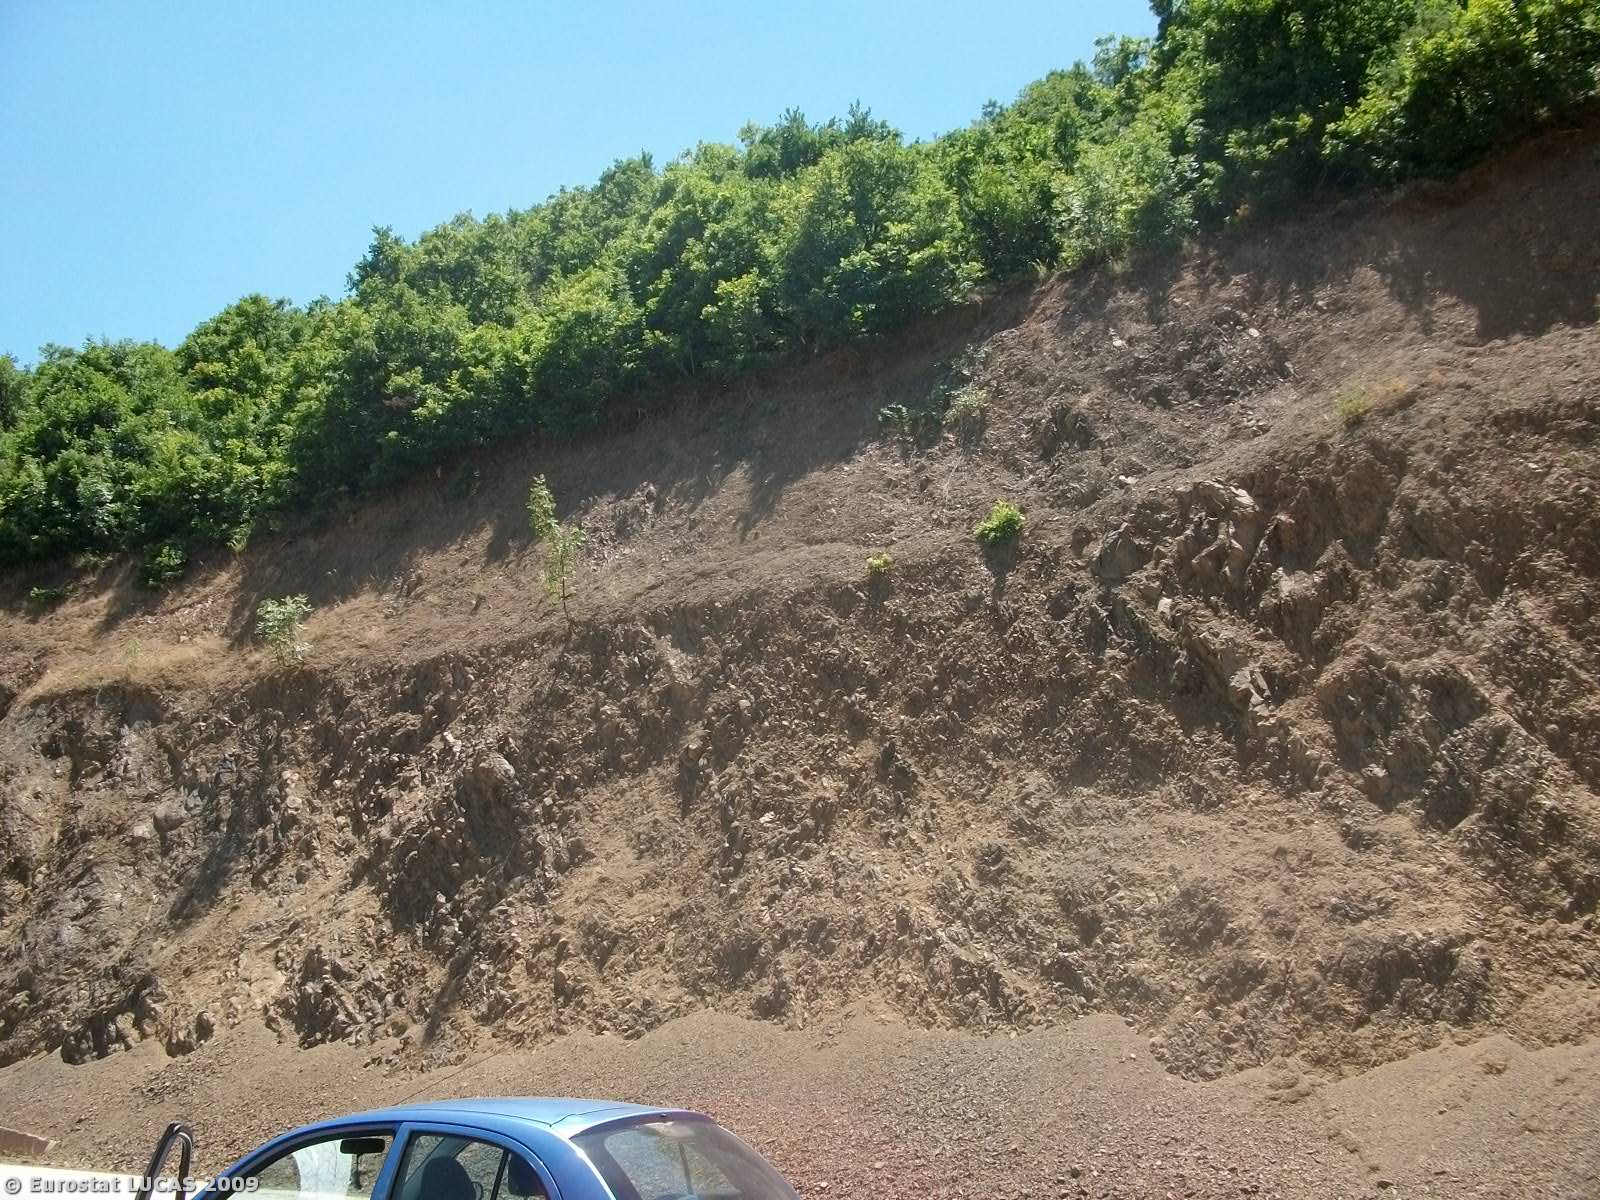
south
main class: Woodland
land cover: Broadleaved woodland
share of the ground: > 75 %
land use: Forestry
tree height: < 5 m
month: July
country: GR
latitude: 39.1910
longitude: 21.9170
